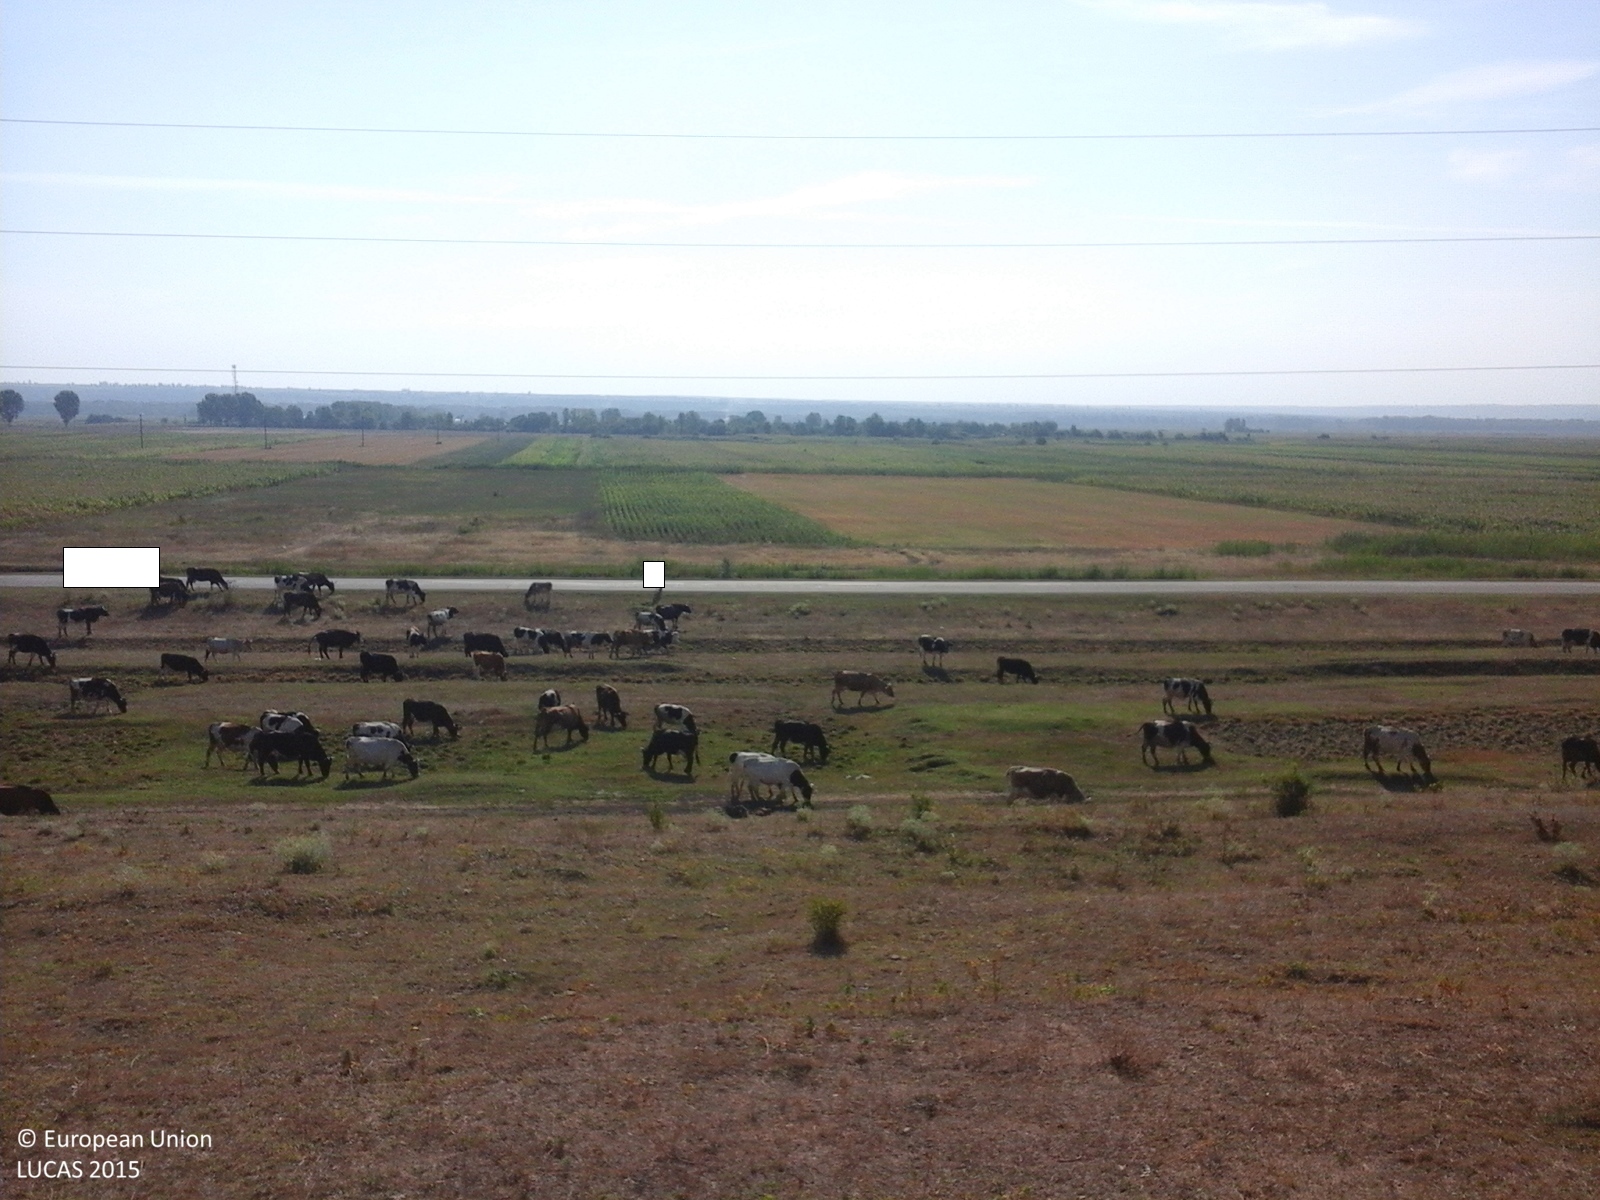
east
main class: Grassland
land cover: Grassland with sparse tree/shrub cover
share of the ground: > 75 %
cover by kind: herbaceous plants 85 %, shrubs 10 %, broadleaved forest trees 5 %
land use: Agriculture (excluding fallow land and kitchen gardens)
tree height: < 5 m
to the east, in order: Grassland with sparse tree/shrub cover; Tracks; Grassland without tree/shrub cover; Electric lines; Grass margins; Ditches and canals; Grassland without tree/shrub cover; Ditches and canals; Grassland without tree/shrub cover; Paved roads, cycling and walking lanes; Grassland without tree/shrub cover; Tracks; Grass margins; Ditches and canals; Grass margins; Tracks; Grassland without tree/shrub cover; Lucerne
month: July
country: RO
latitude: 46.5661
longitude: 28.1754
